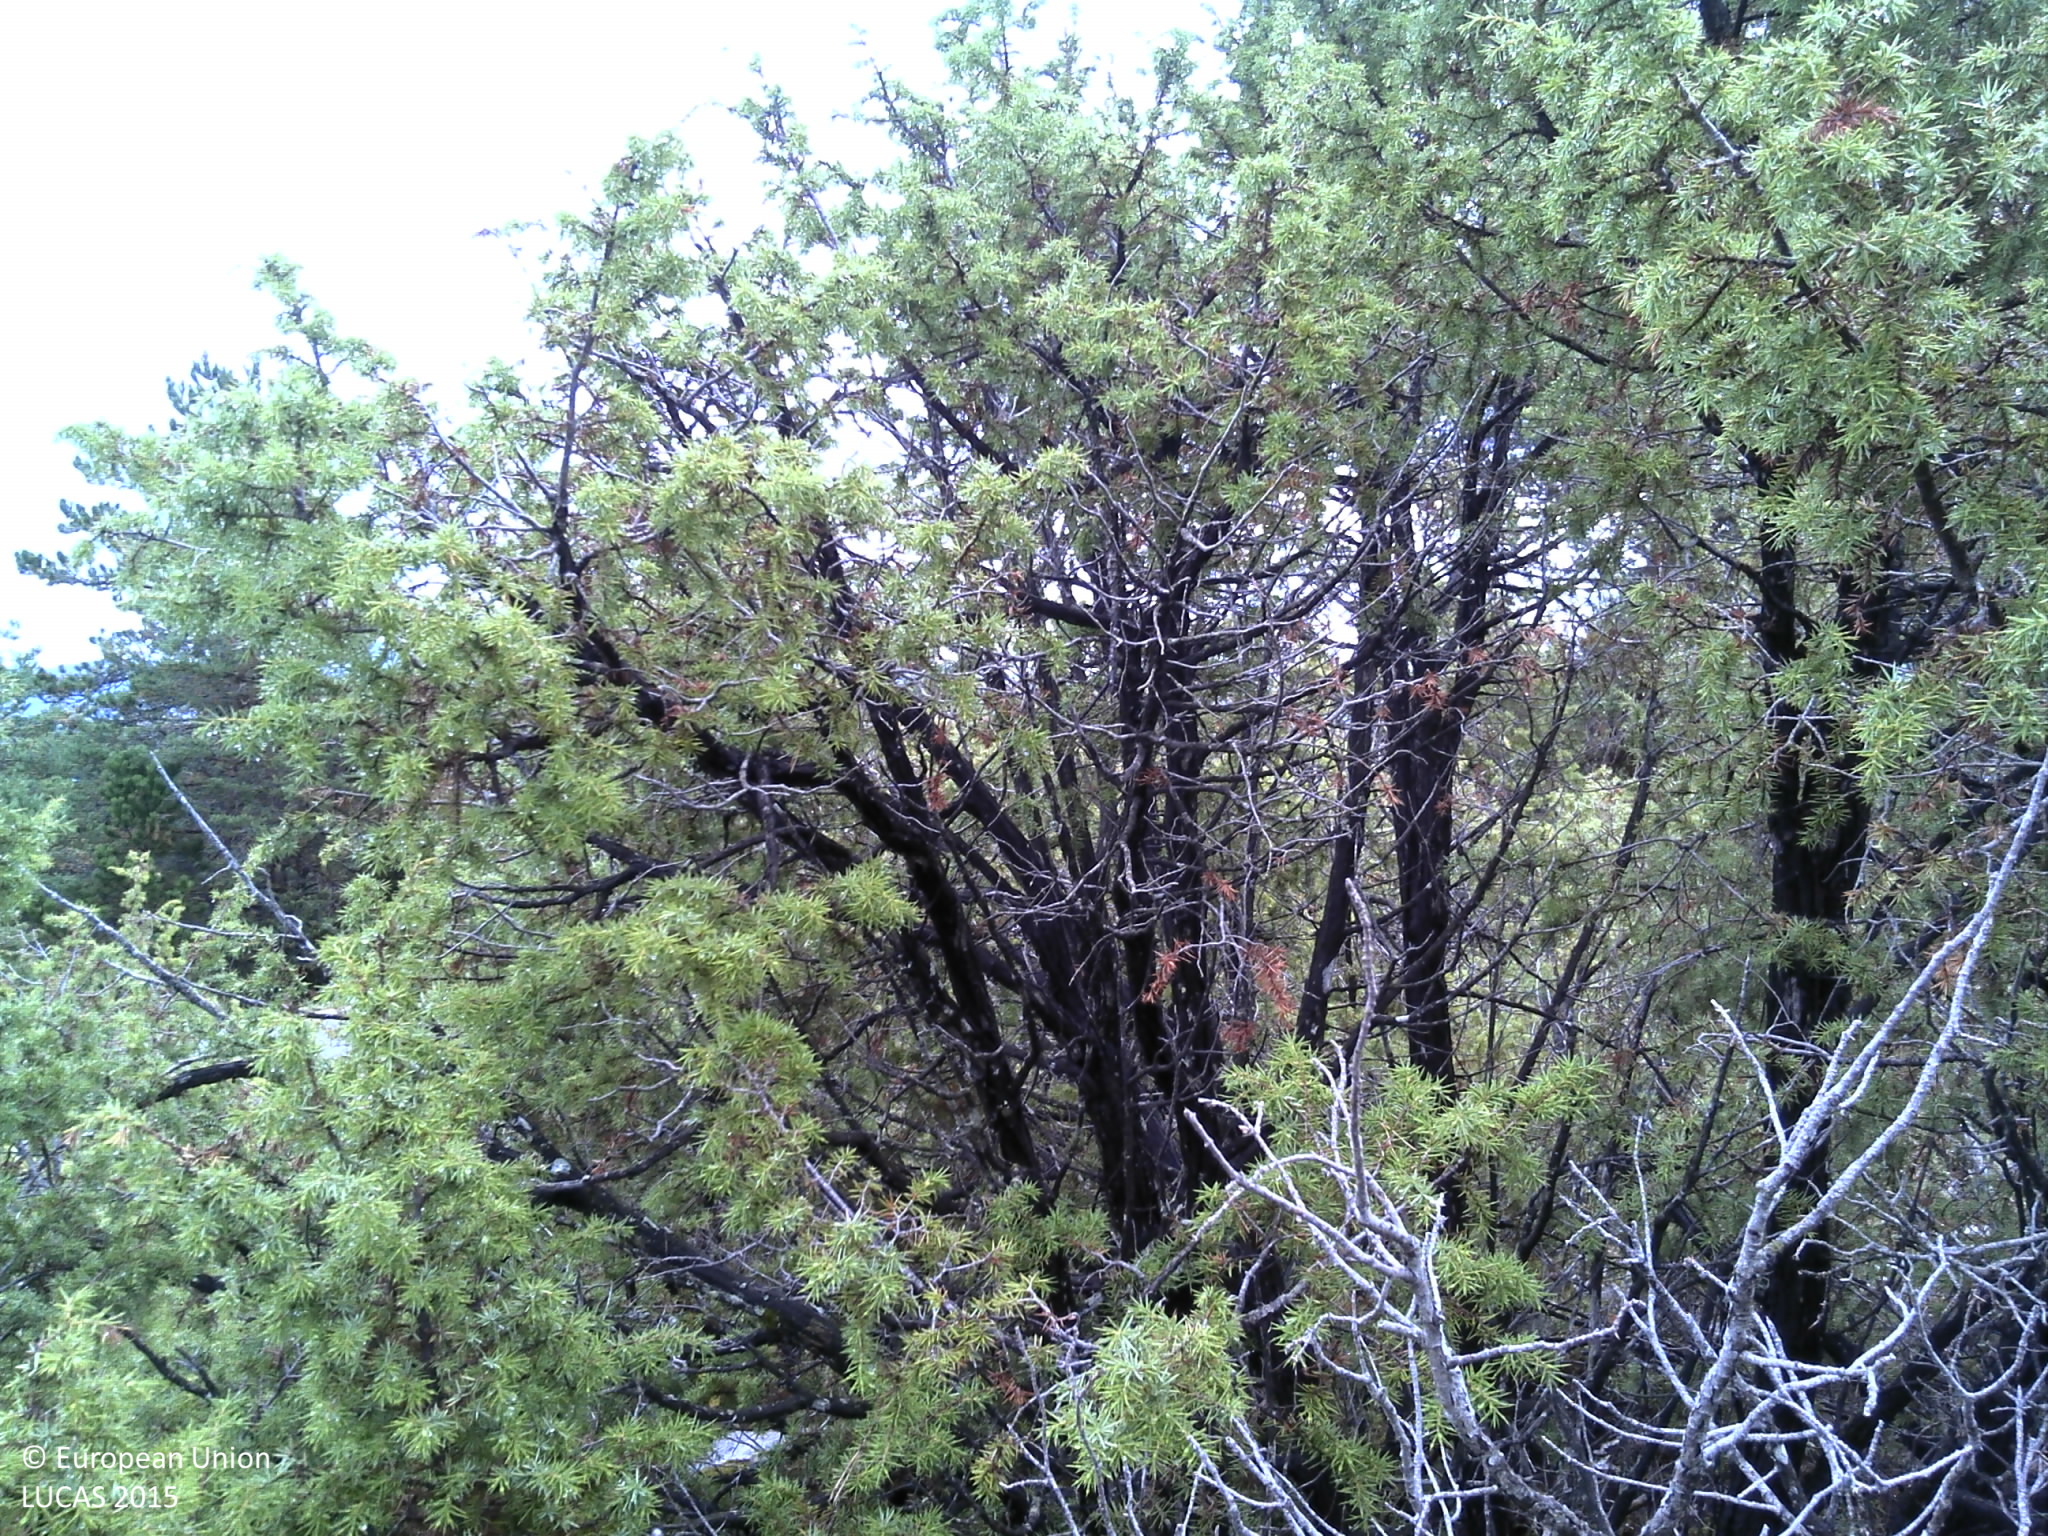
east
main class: Woodland
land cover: Pine dominated coniferous woodland
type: coniferous forest of the mediterranean region
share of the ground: > 75 %
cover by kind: coniferous forest trees 75 %, shrubs 15 %, lichens and mosses 5 %, consolidated bare surface 5 %
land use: Semi-natural and natural areas not in use
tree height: > 5 m
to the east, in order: Pine dominated coniferous woodland; Paved roads, cycling and walking lanes; Shrubland without tree cover; Pine dominated coniferous woodland; Shrubland with sparse tree cover; Pine dominated coniferous woodland; Shrubland with sparse tree cover; Pine dominated mixed woodland
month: September
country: FR
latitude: 43.7471
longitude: 6.4192
